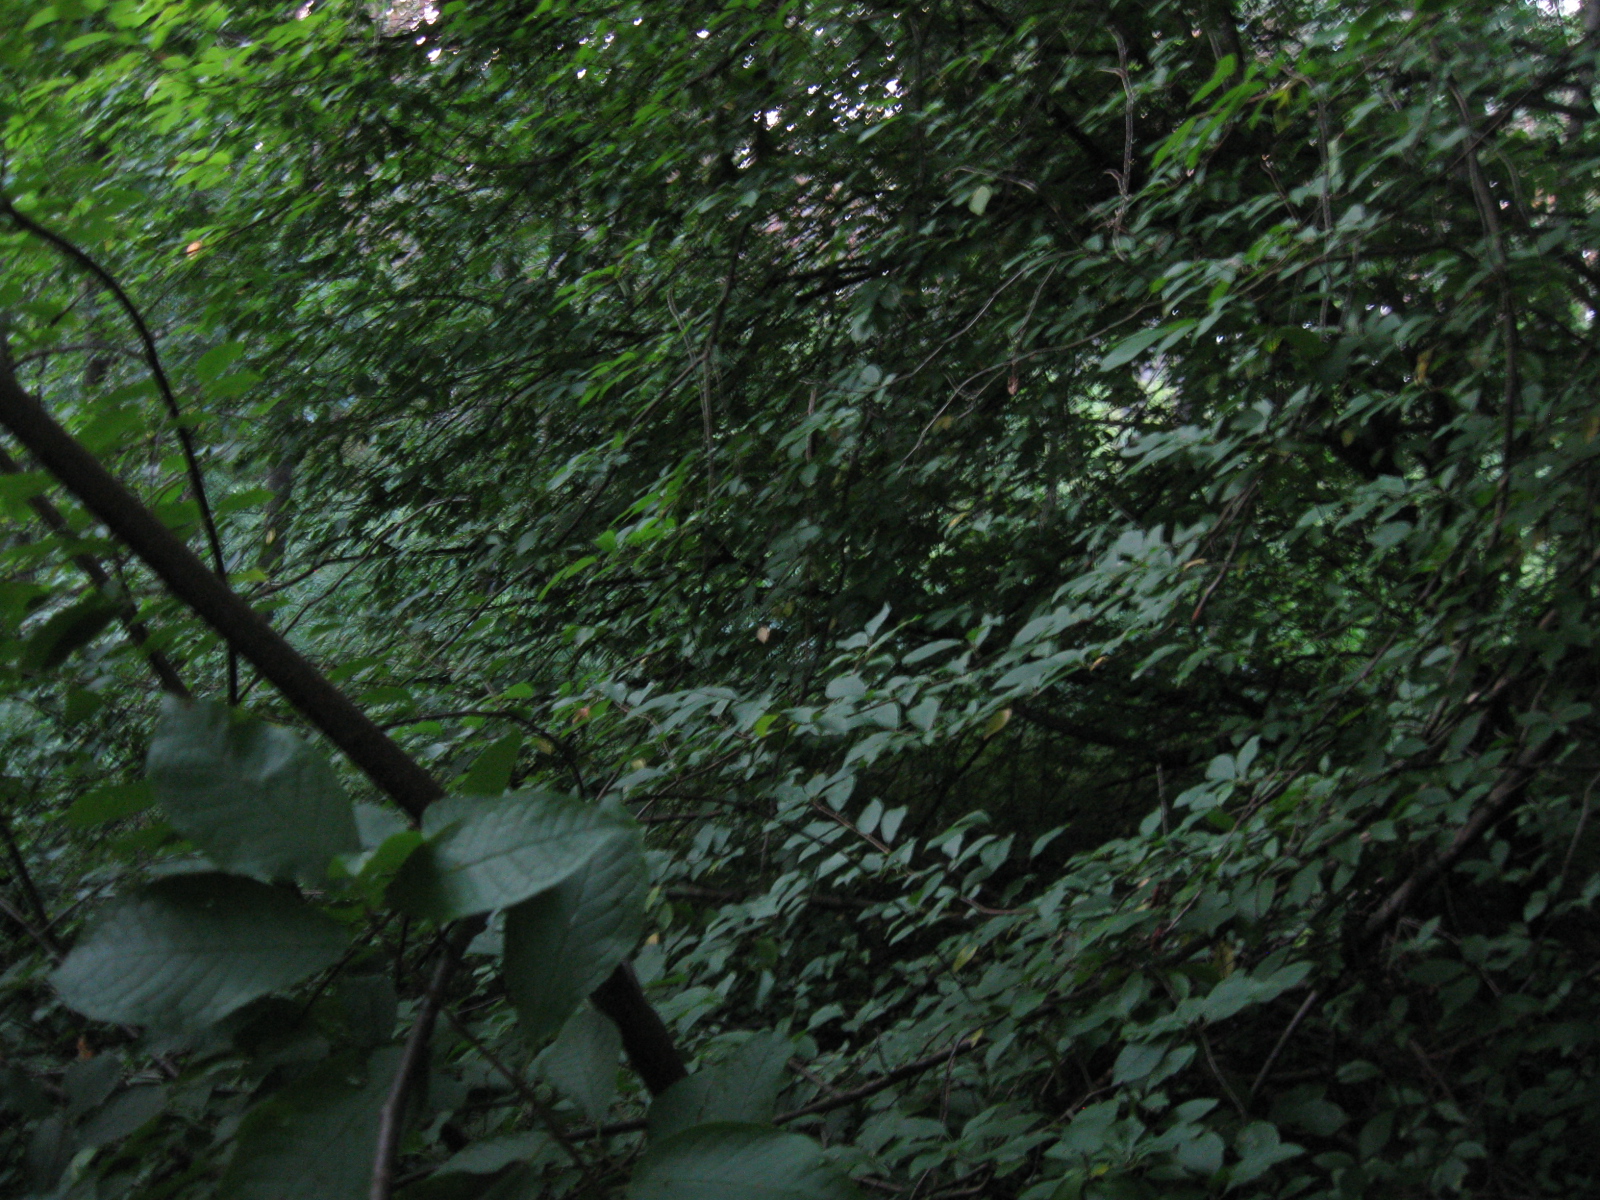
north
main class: Woodland
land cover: Broadleaved woodland
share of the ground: > 75 %
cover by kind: broadleaved forest trees 90 %, shrubs 5 %, herbaceous plants 5 %
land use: Forestry
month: July
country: LT
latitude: 54.3847
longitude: 24.3744
